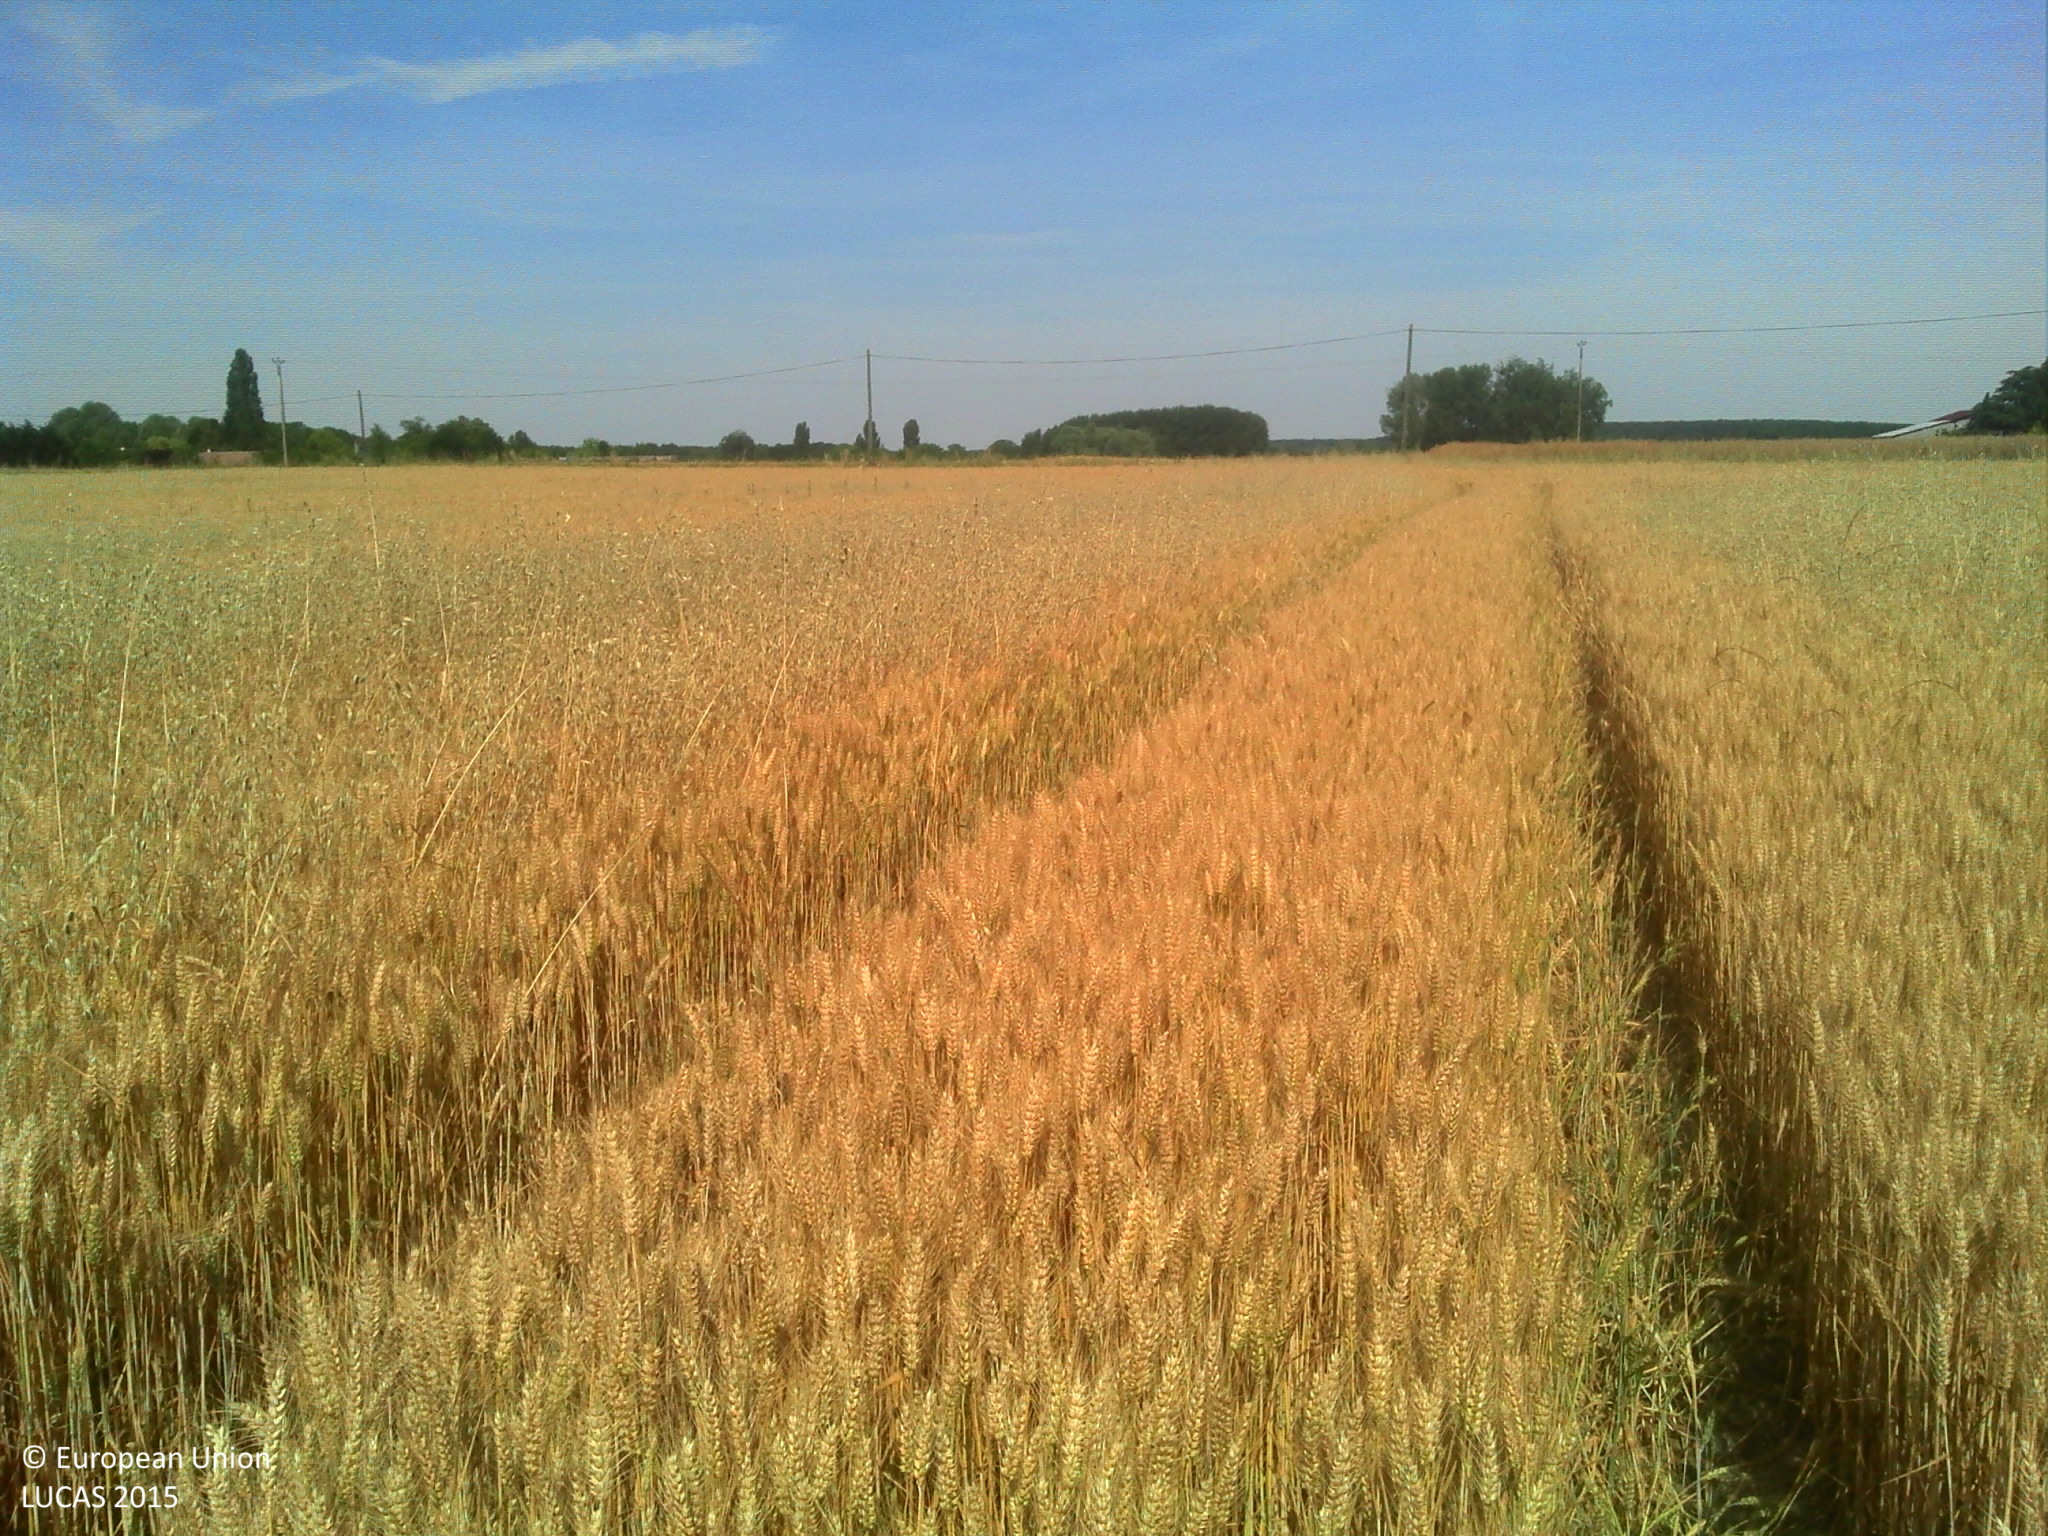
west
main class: Cropland
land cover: Common wheat
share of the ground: > 75 %
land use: Agriculture (excluding fallow land and kitchen gardens)
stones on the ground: < 10 %
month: June
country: FR
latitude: 47.5066
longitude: 1.3953
